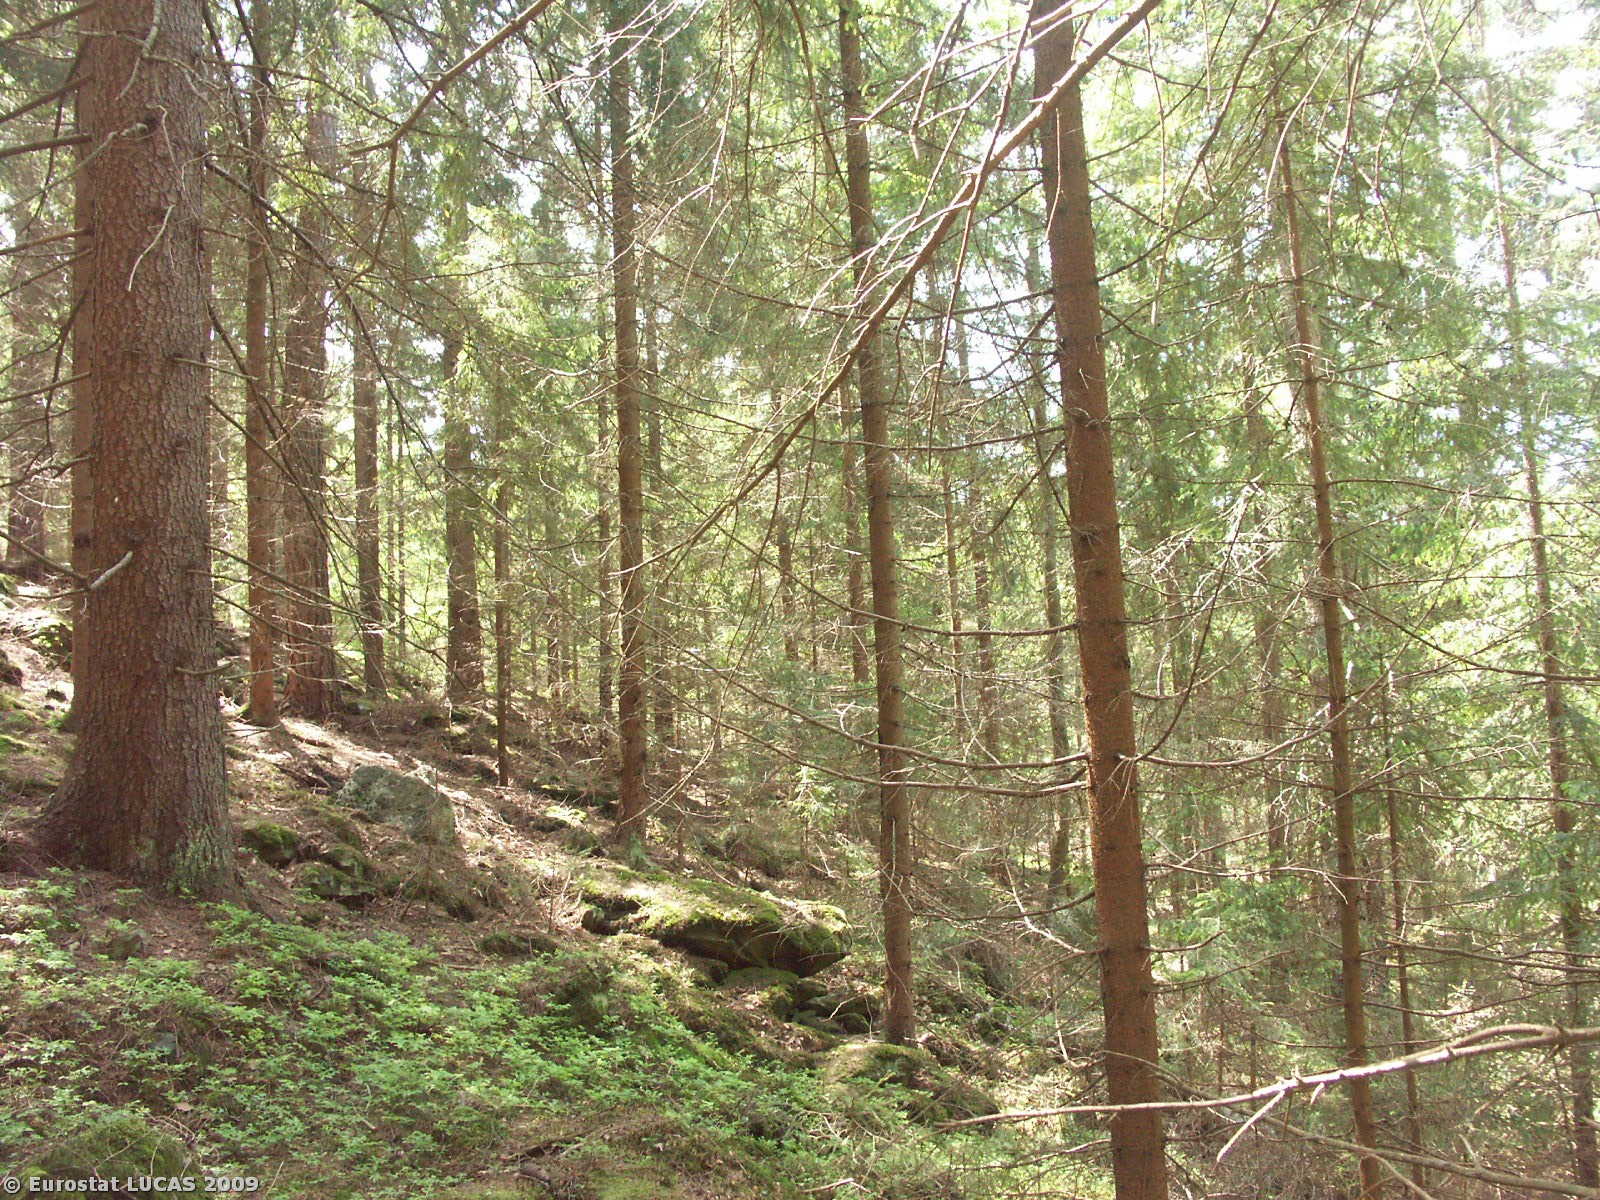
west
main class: Woodland
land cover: Coniferous woodland
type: hemiboreal forest and nemoral coniferous forest and mixed broadleaved-coniferous forest
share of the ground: > 75 %
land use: Forestry
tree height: > 5 m
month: May
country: CZ
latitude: 48.7028
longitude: 14.6346
